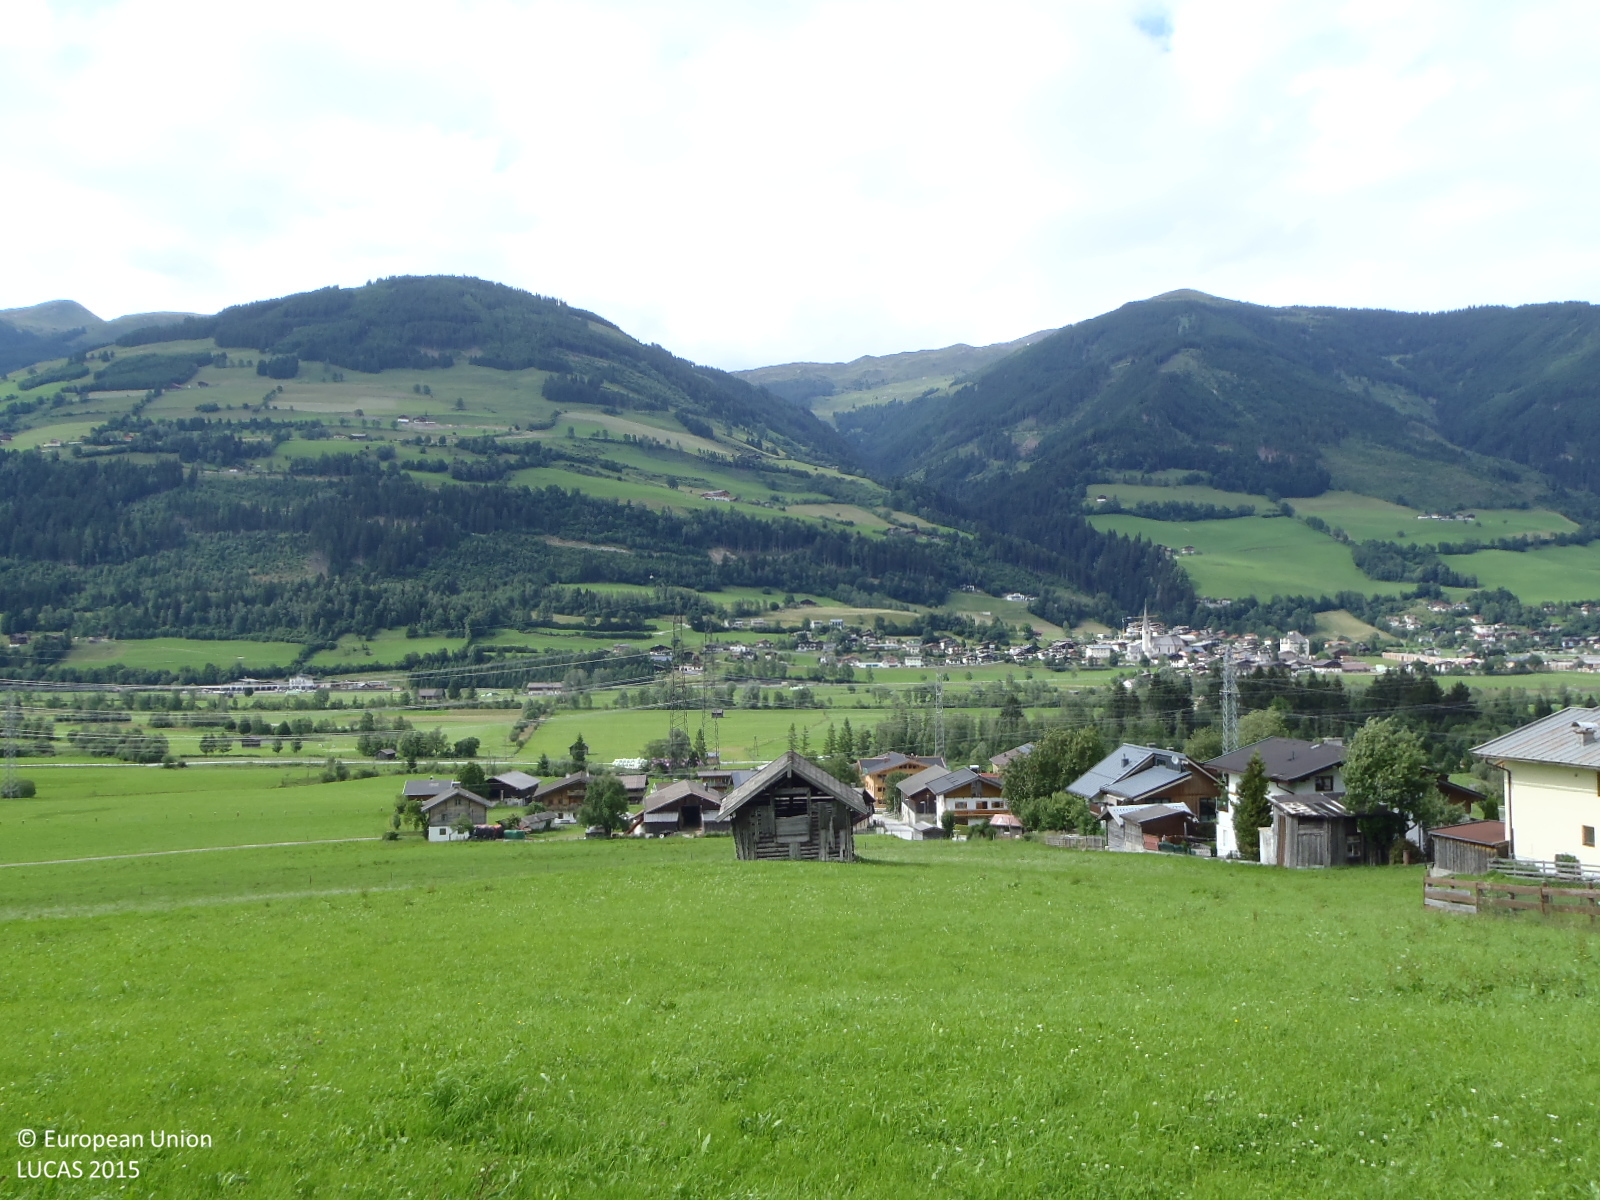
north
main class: Grassland
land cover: Grassland without tree/shrub cover
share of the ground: > 75 %
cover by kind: herbaceous plants 100 %
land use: Agriculture (excluding fallow land and kitchen gardens)
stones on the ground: < 10 %
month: June
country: AT
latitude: 47.2763
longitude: 12.5230
